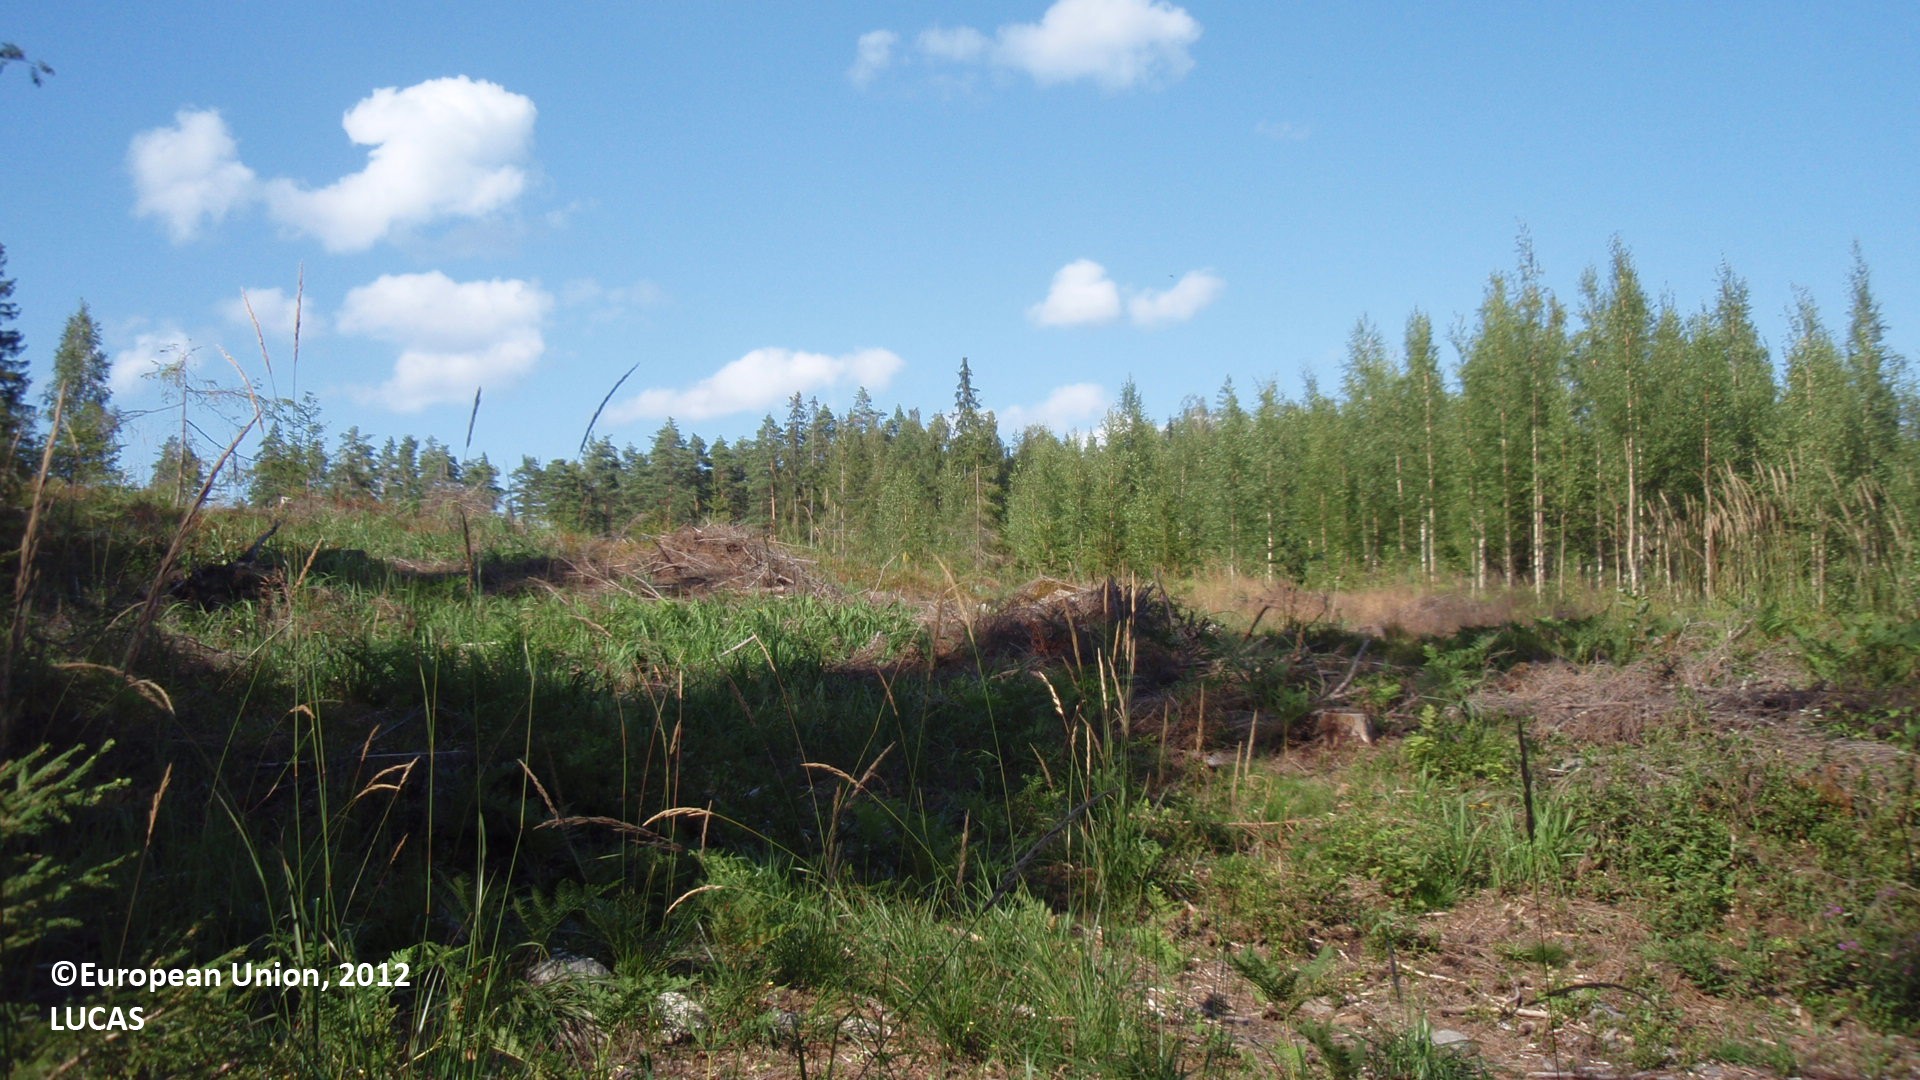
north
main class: Grassland
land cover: Grassland with sparse tree/shrub cover
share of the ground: 25 - 50 %
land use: Forestry
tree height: < 5 m
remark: Clear cut
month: July
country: FI
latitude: 61.1641
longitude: 28.2540
